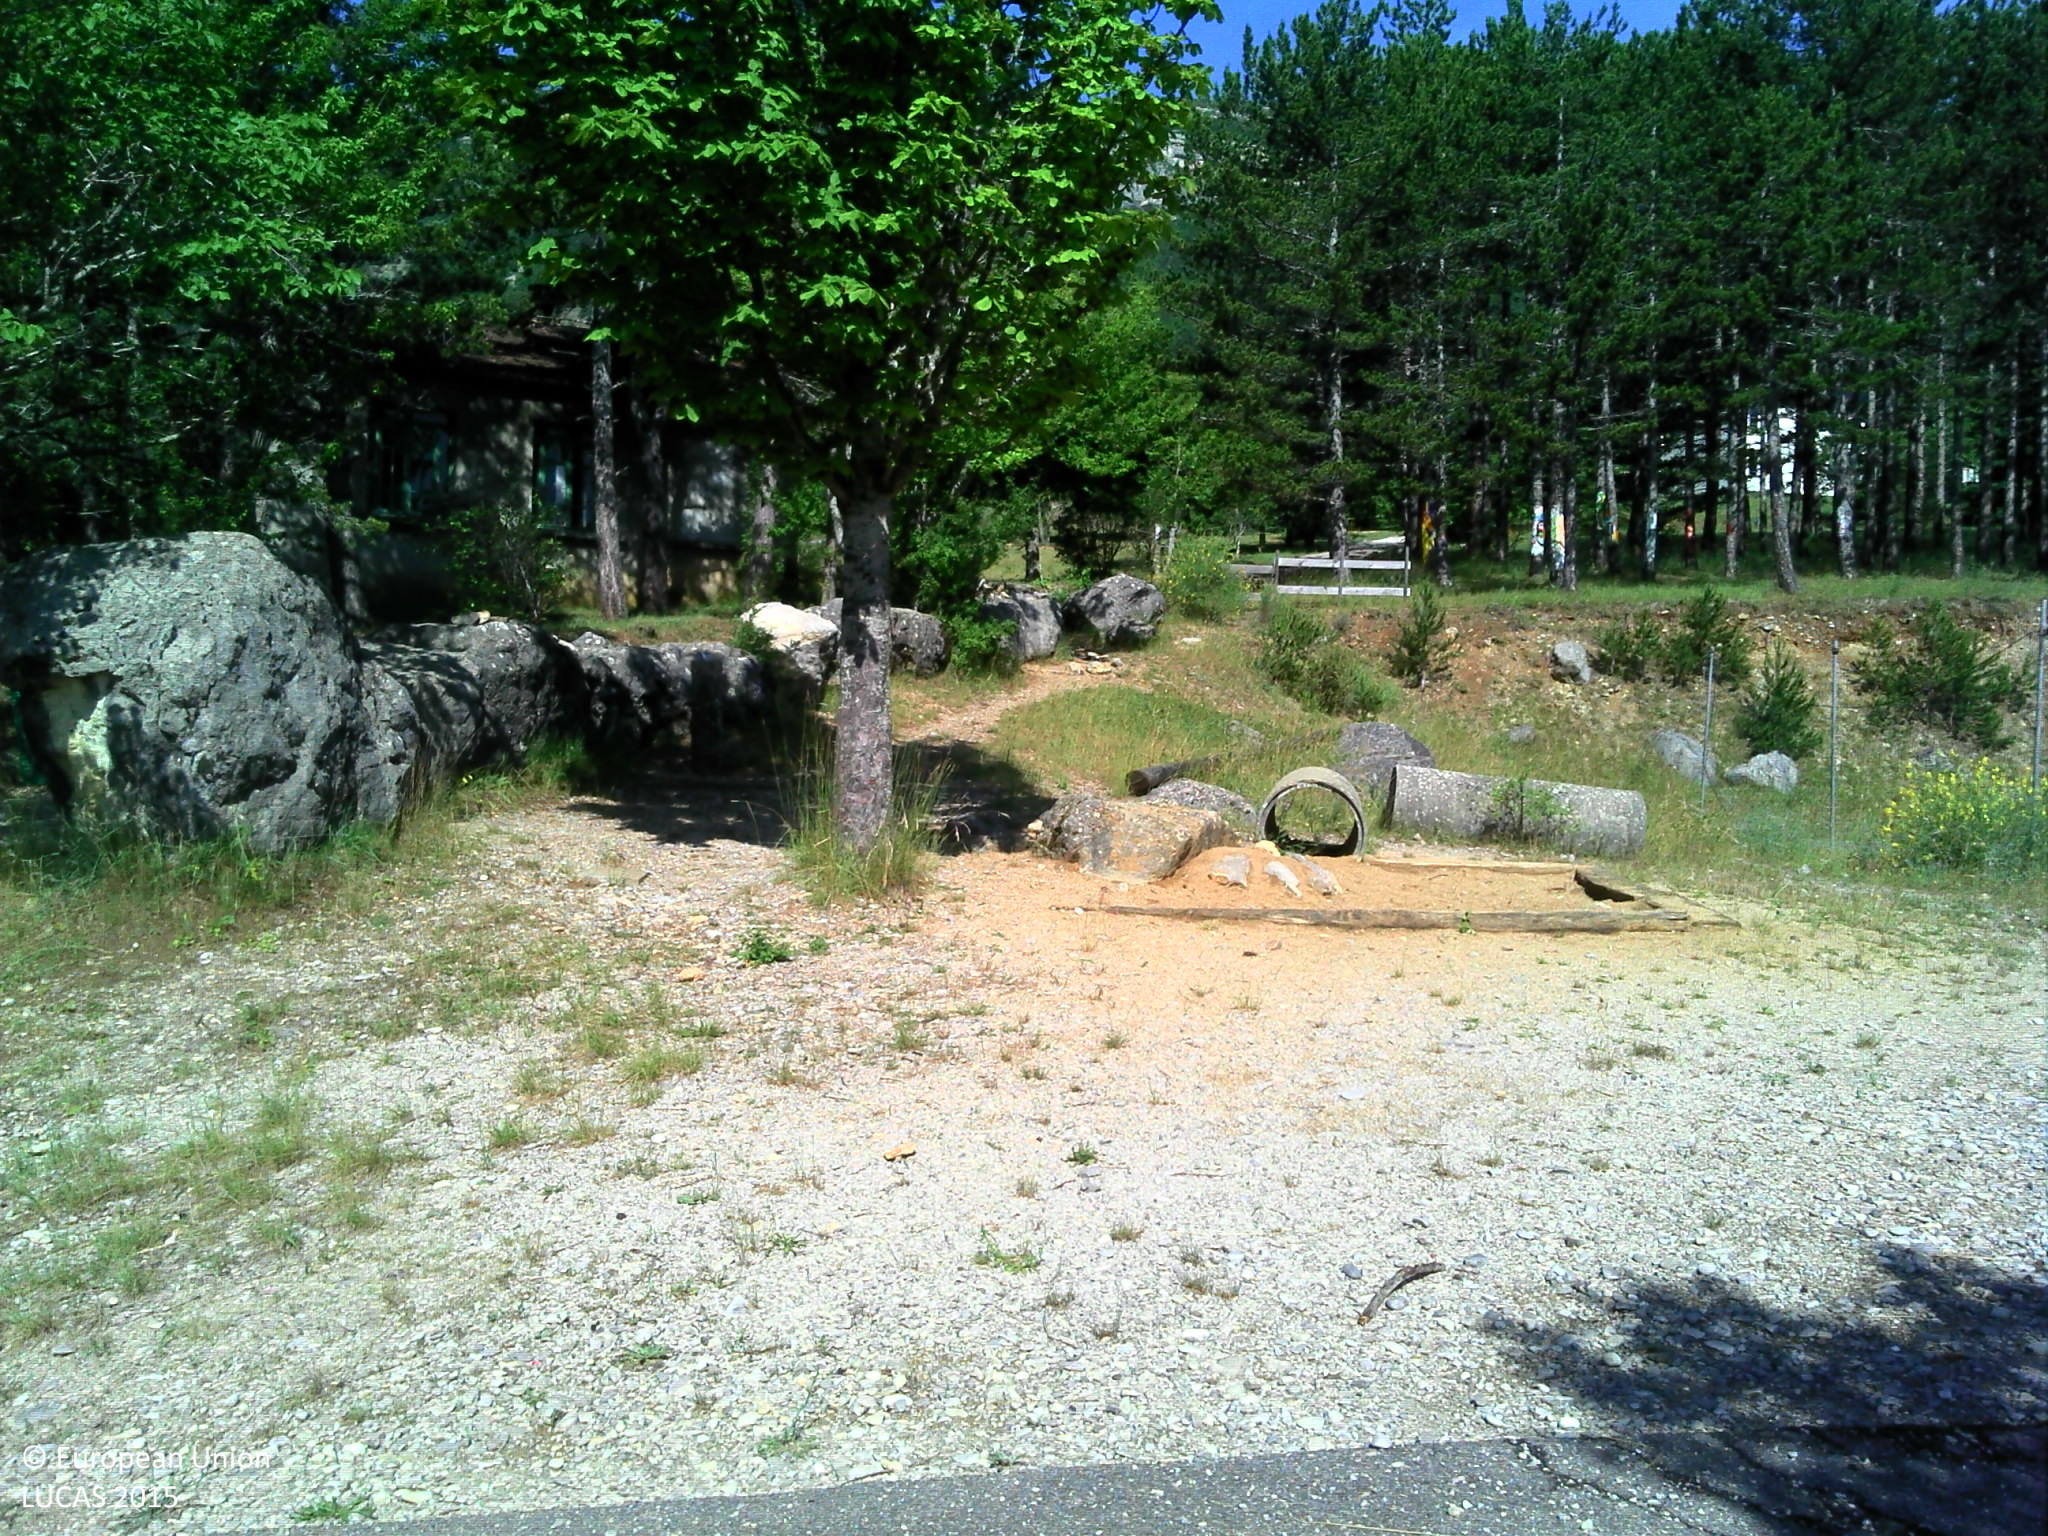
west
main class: Shrubland
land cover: Shrubland with sparse tree cover
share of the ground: > 75 %
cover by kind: herbaceous plants 85 %, shrubs 10 %, broadleaved forest trees 5 %
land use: Residential
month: June
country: FR
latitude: 44.7113
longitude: 5.2477
